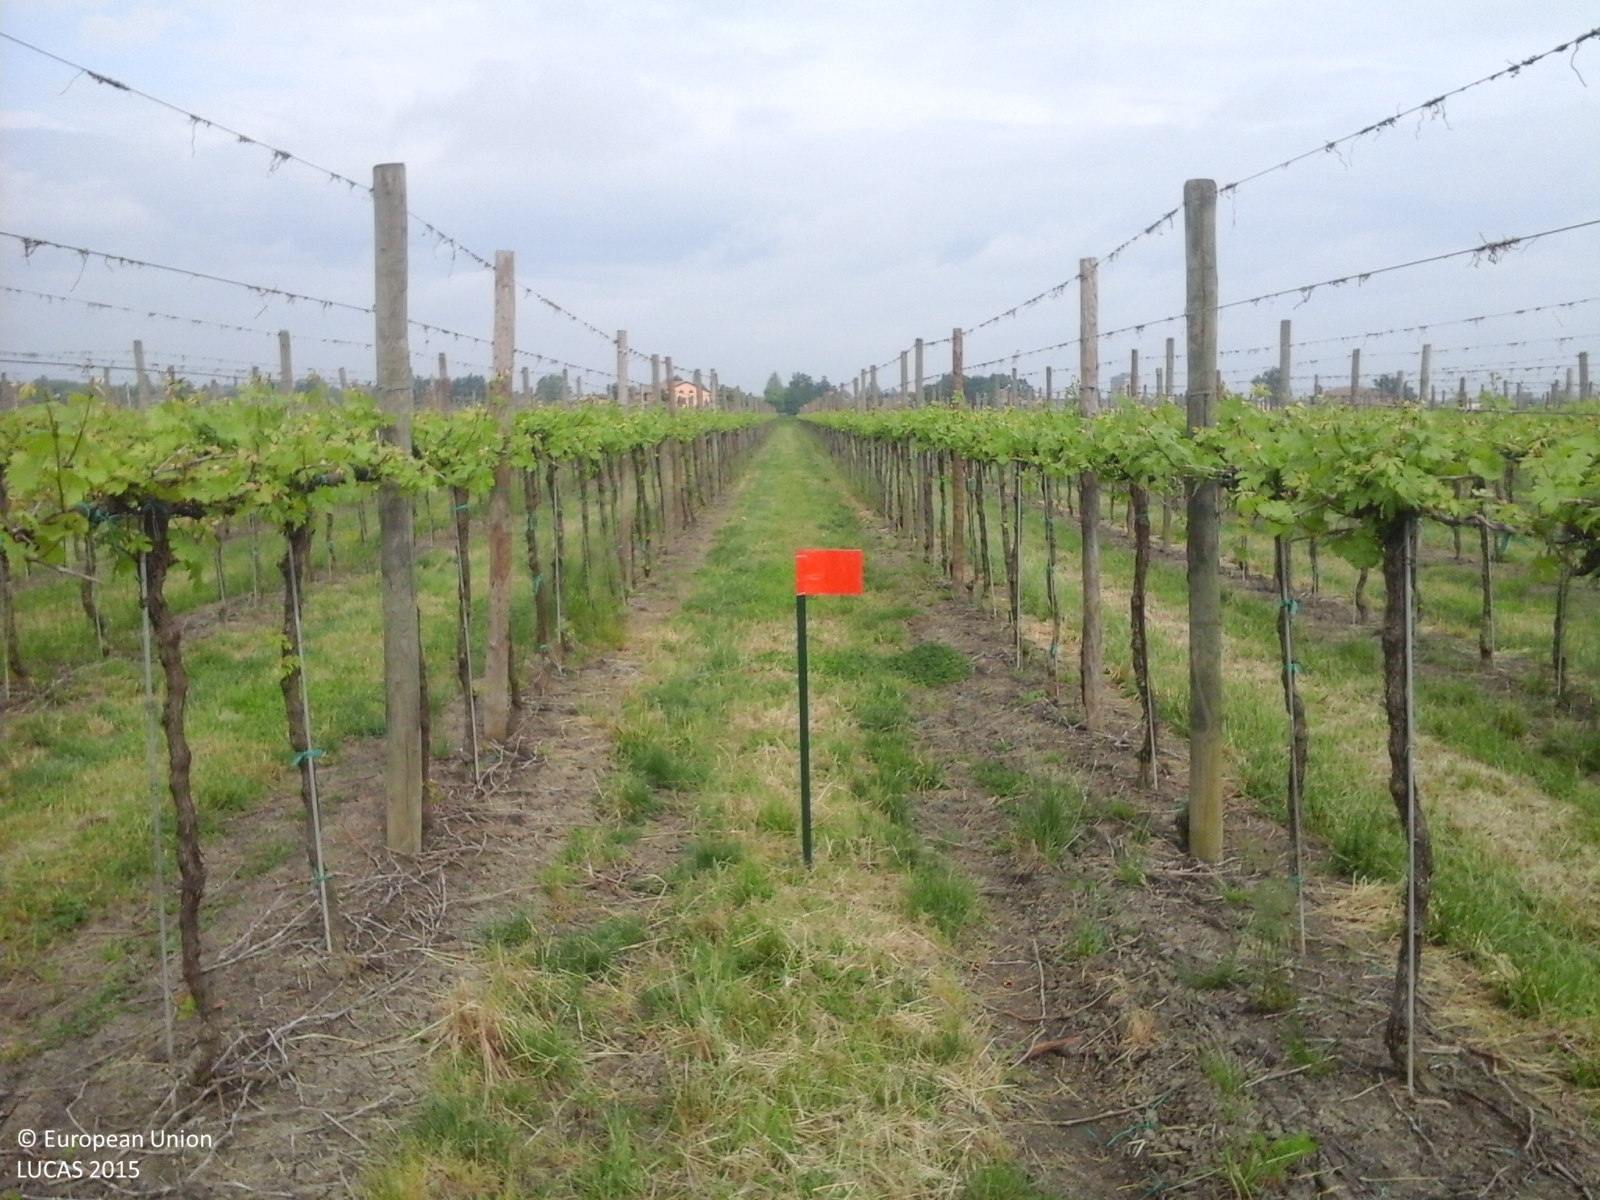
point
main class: Cropland
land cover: Vineyards
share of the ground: 10 - 25 %
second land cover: Grassland without tree/shrub cover
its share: > 75 %
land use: Agriculture (excluding fallow land and kitchen gardens)
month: April
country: IT
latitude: 44.8348
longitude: 10.7448
